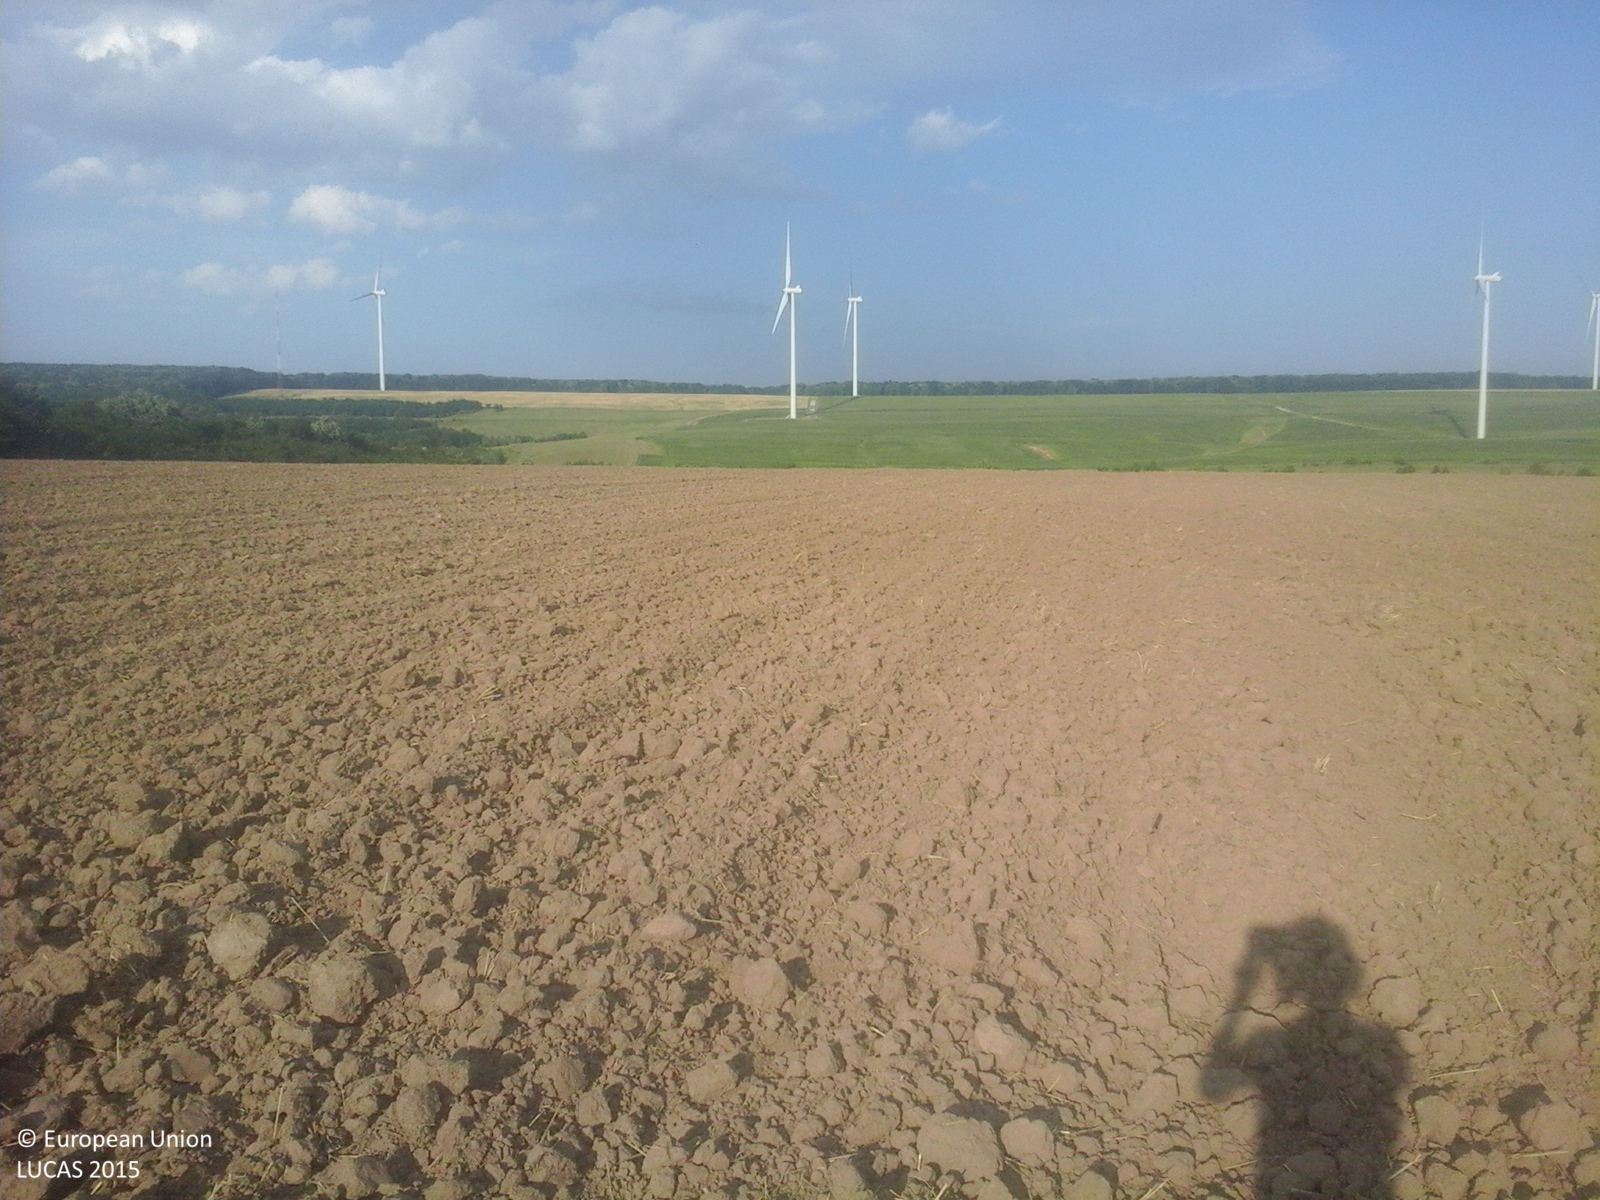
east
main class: Cropland
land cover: Durum wheat
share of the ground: < 10 %
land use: Agriculture (excluding fallow land and kitchen gardens)
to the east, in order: Durum wheat
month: July
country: RO
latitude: 46.5400
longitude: 27.8967
